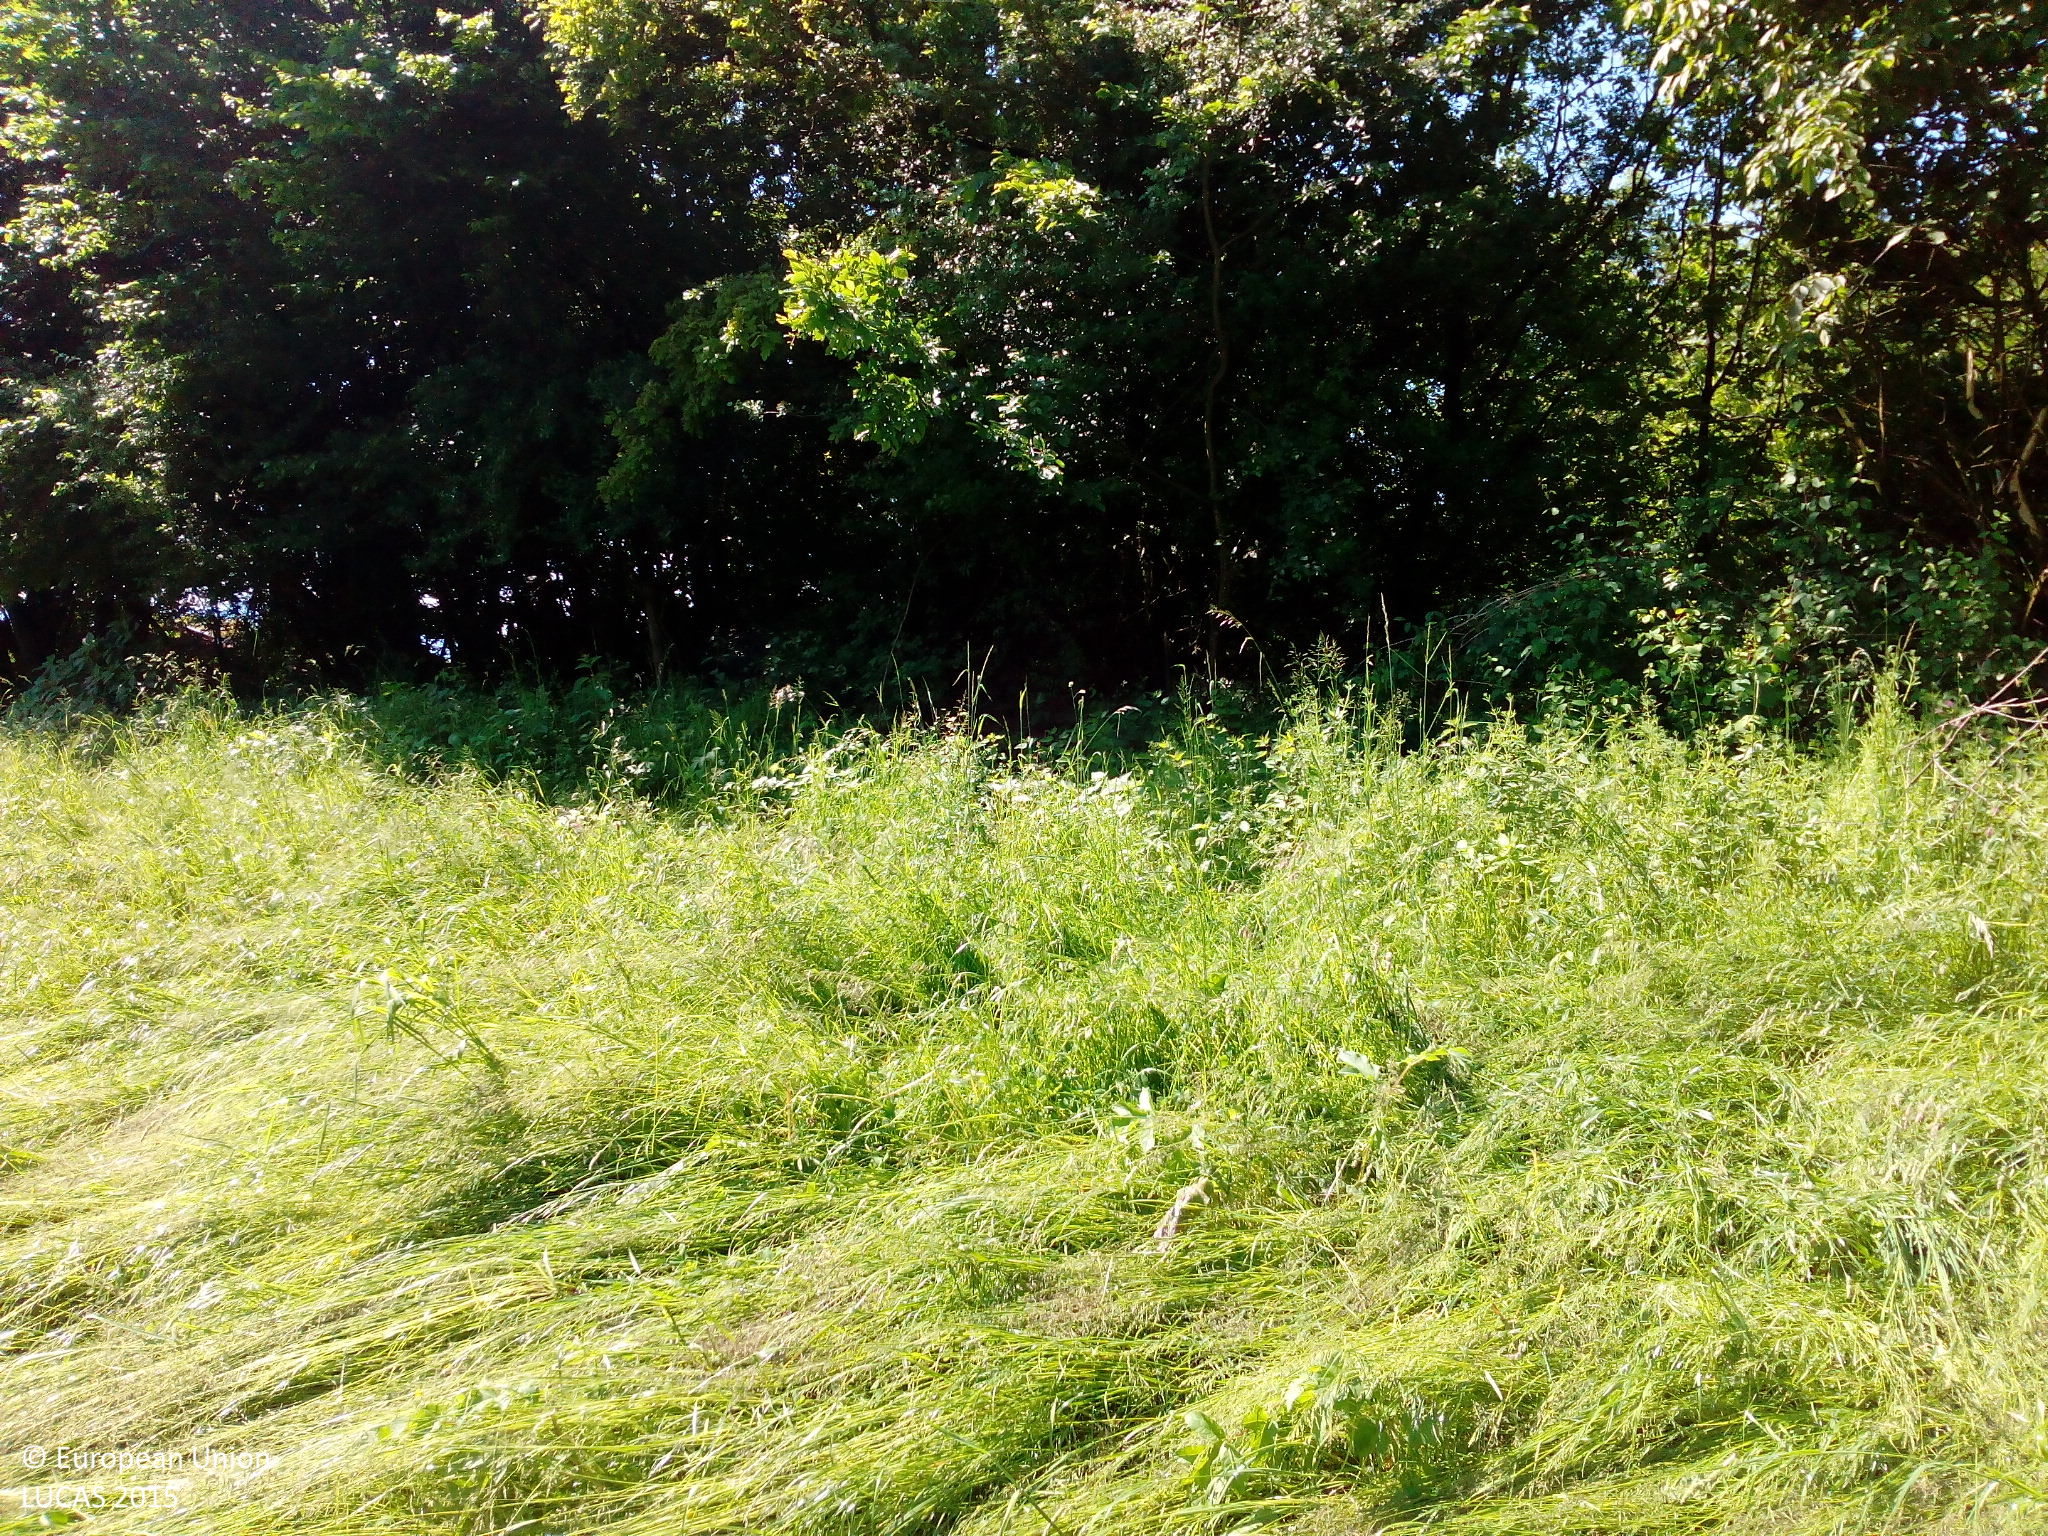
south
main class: Grassland
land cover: Grassland without tree/shrub cover
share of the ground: > 75 %
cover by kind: herbaceous plants 100 %
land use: Agriculture (excluding fallow land and kitchen gardens)
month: June
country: DE
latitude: 47.9461
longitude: 12.3685
